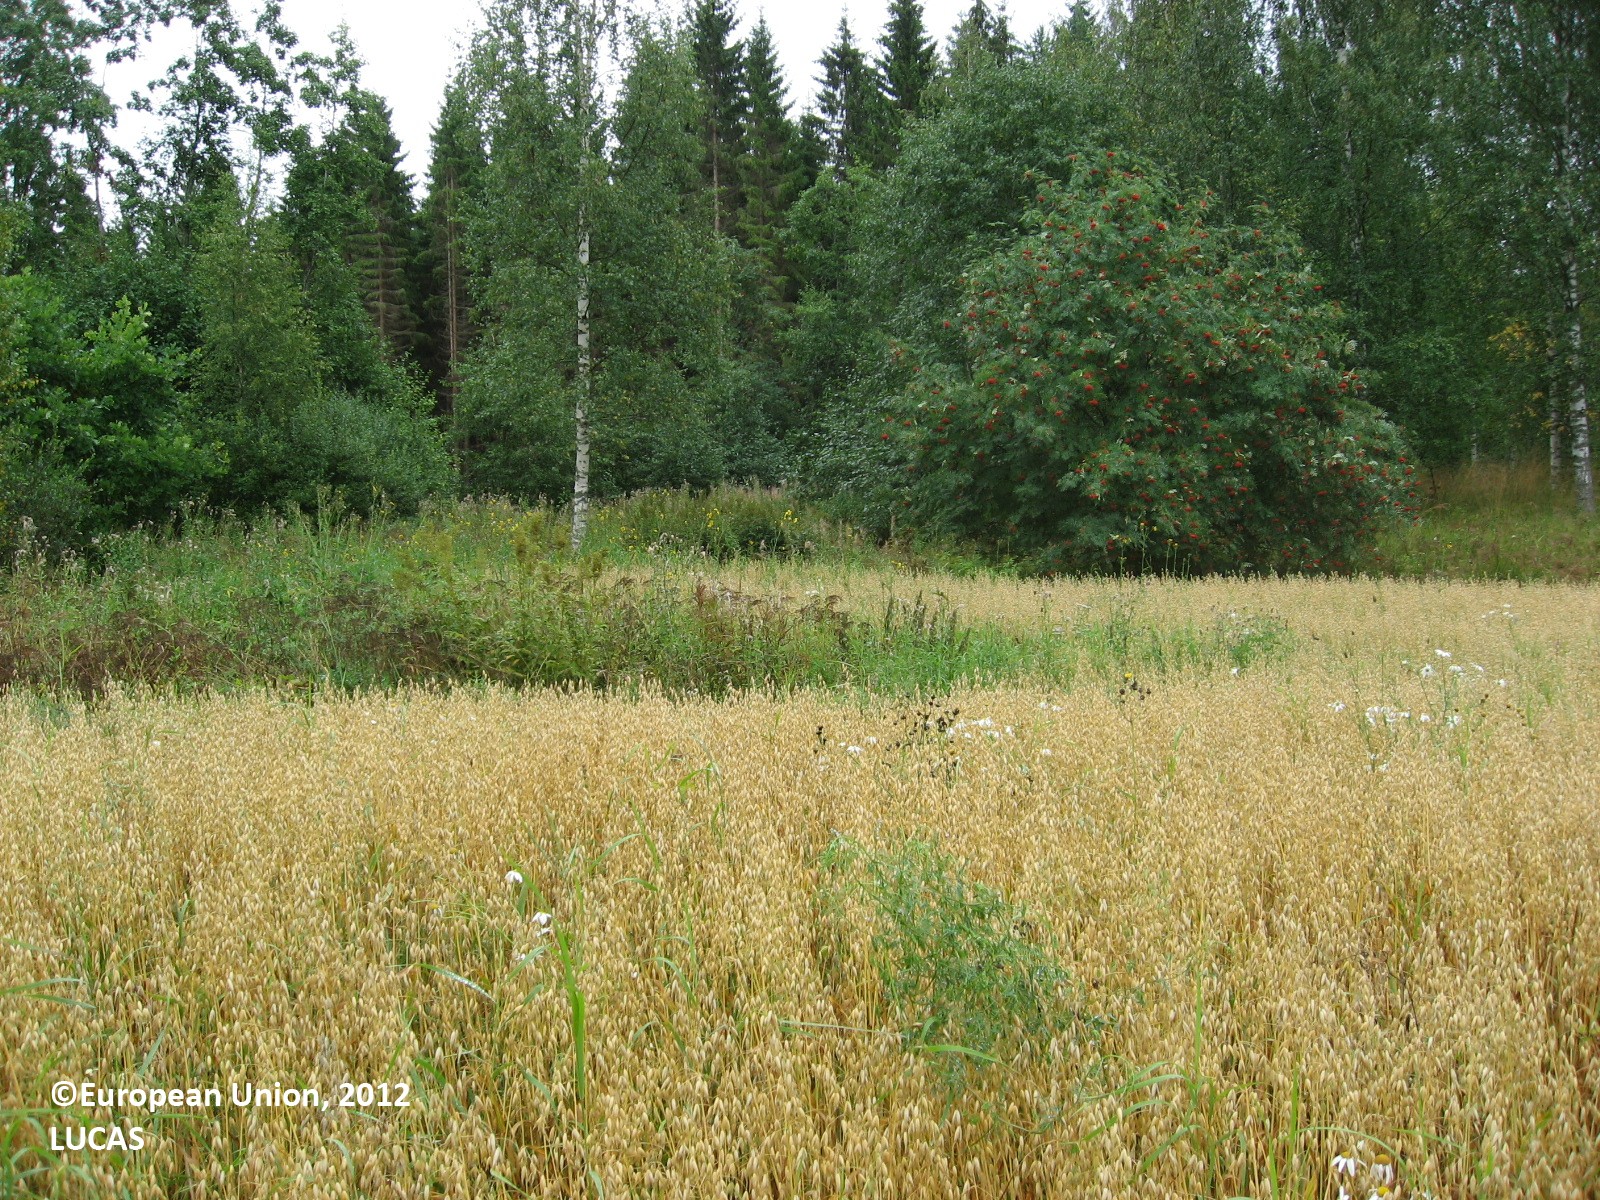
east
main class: Cropland
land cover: Oats
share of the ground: > 75 %
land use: Agriculture (excluding fallow land and kitchen gardens)
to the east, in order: Oats; Grass margins; Ditches and canals; Grass margins; Oats; Grass margins; Ditches and canals; Grass margins; Oats; Grass margins; Ditches and canals; Grass margins; Oats; Grass margins; Ditches and canals; Grass margins; Oats; Grass margins; Ditches and canals; Grass margins; Oats; Grass margins; Ditches and canals; Other mixed woodland; Spontaneously vegetated surfaces; Inland water bodies; Grassland without tree/shrub cover
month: August
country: FI
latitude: 61.4351
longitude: 24.7846
